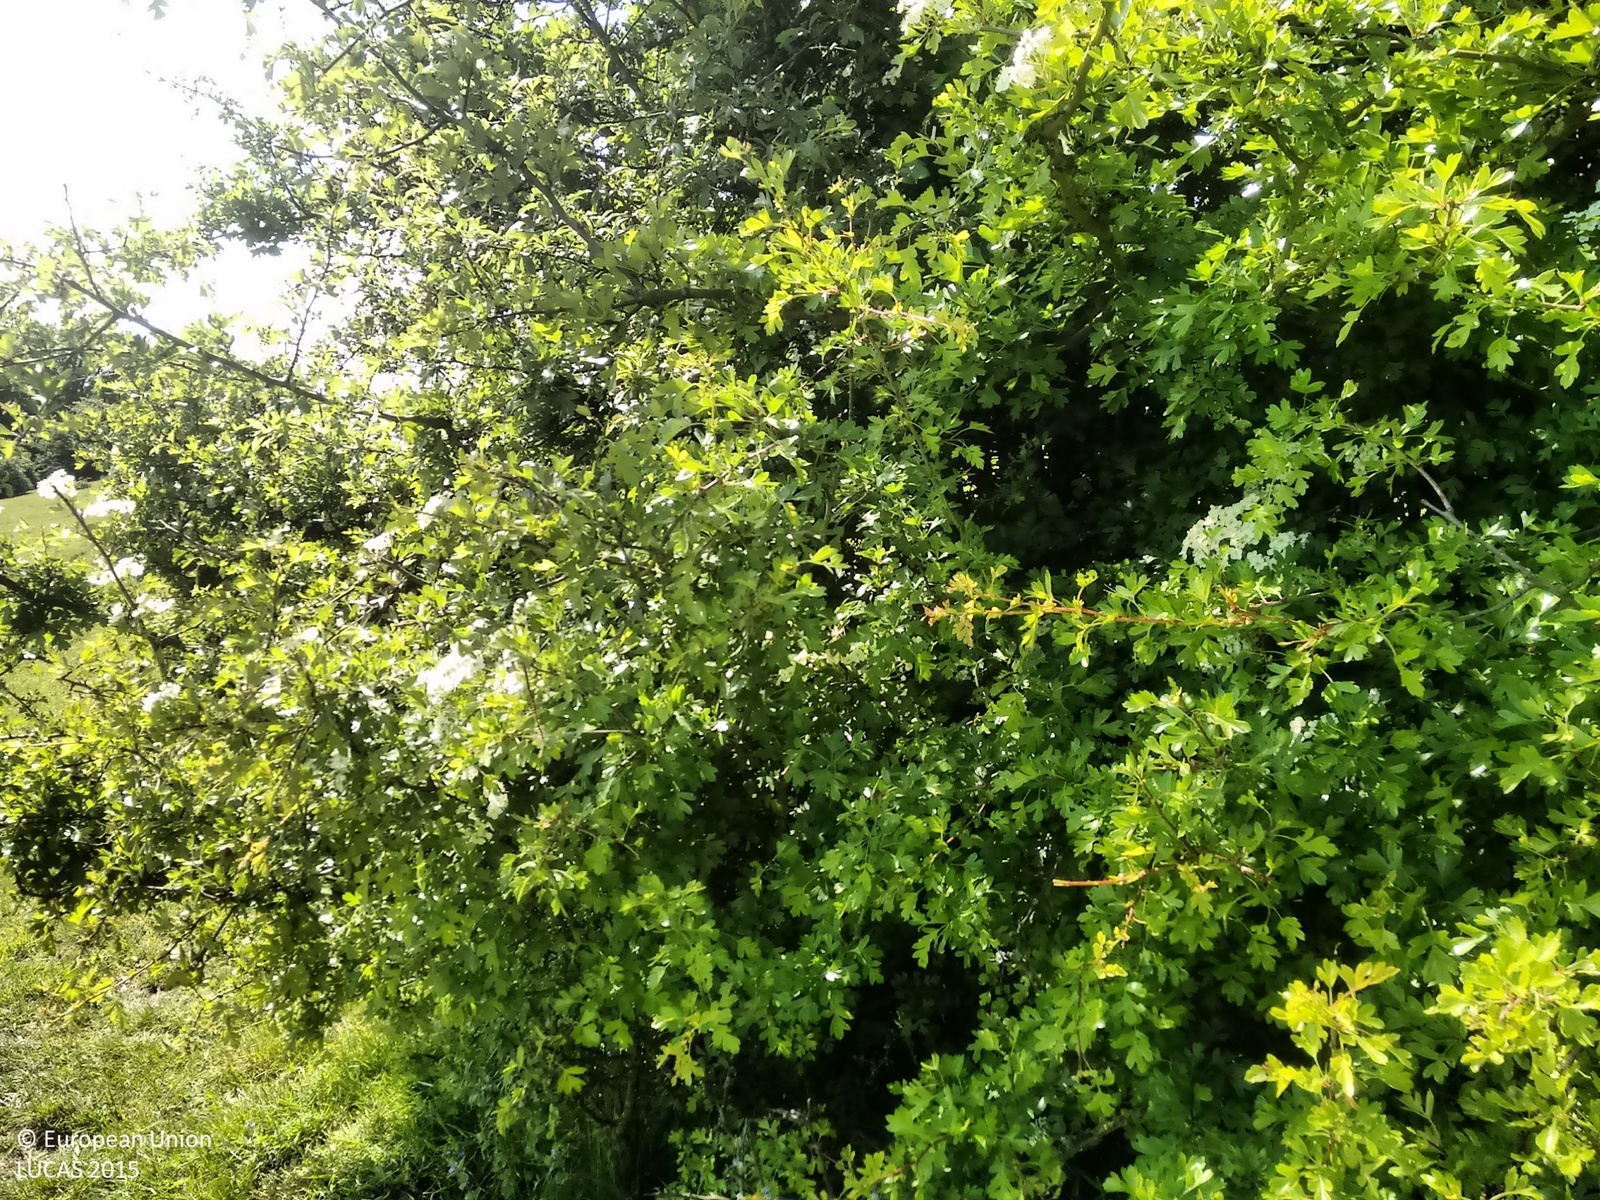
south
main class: Grassland
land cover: Grassland with sparse tree/shrub cover
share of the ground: > 75 %
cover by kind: herbaceous plants 85 %, shrubs 10 %, broadleaved forest trees 5 %
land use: Amenities, museums, leisure
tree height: < 5 m
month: May
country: GB
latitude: 51.0849
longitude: 1.1123
